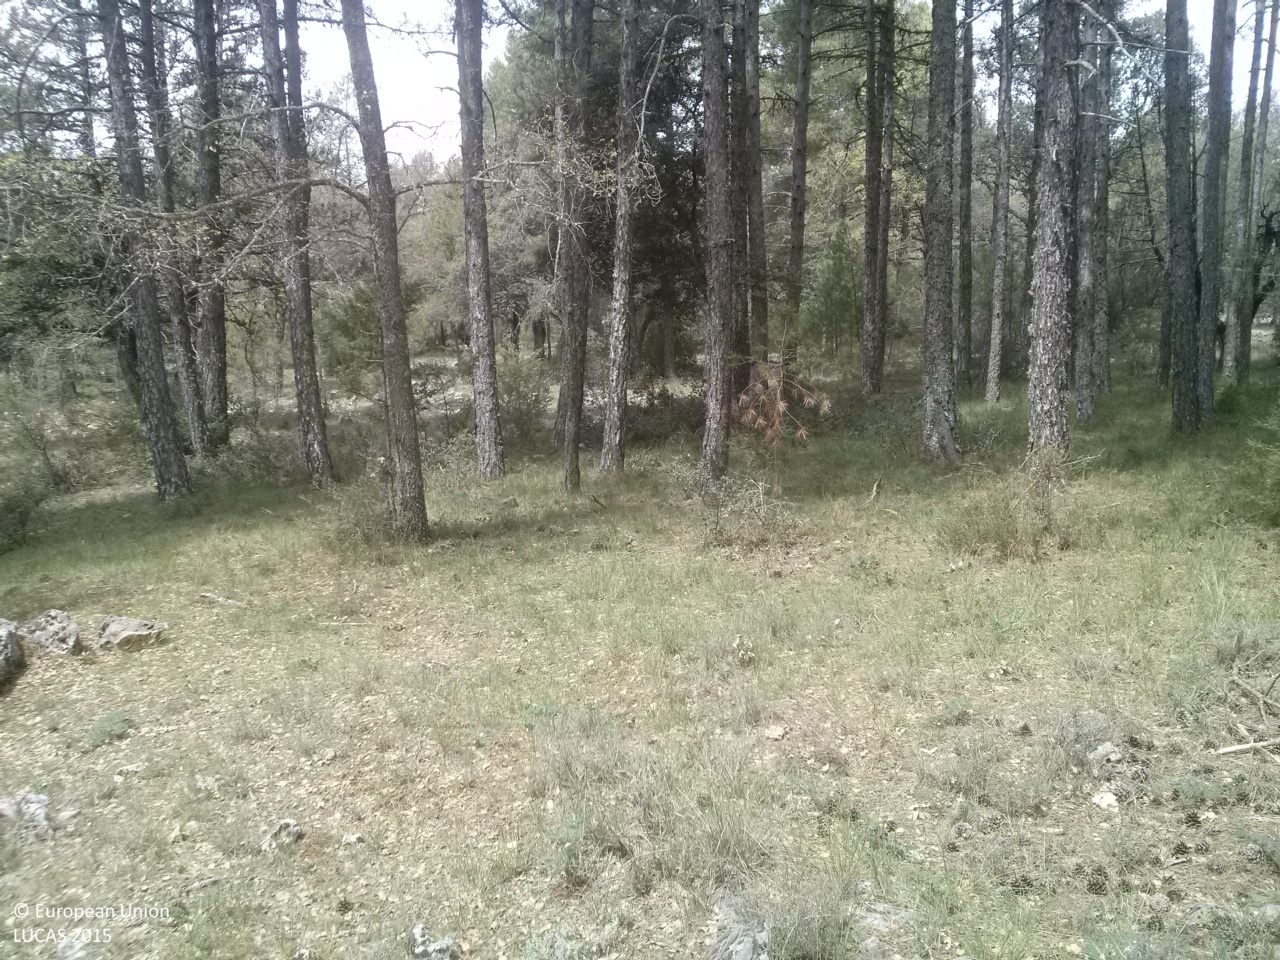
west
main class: Woodland
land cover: Pine dominated mixed woodland
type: coniferous forest of the mediterranean region
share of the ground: 50 - 75 %
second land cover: Shrubland without tree cover
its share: 10 - 25 %
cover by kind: coniferous forest trees 55 %, broadleaved forest trees 20 %, shrubs 15 %, herbaceous plants 10 %
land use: Forestry
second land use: Agriculture (excluding fallow land and kitchen gardens)
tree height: > 5 m
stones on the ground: > 50 %
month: April
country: ES
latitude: 40.0297
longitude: -1.9311
